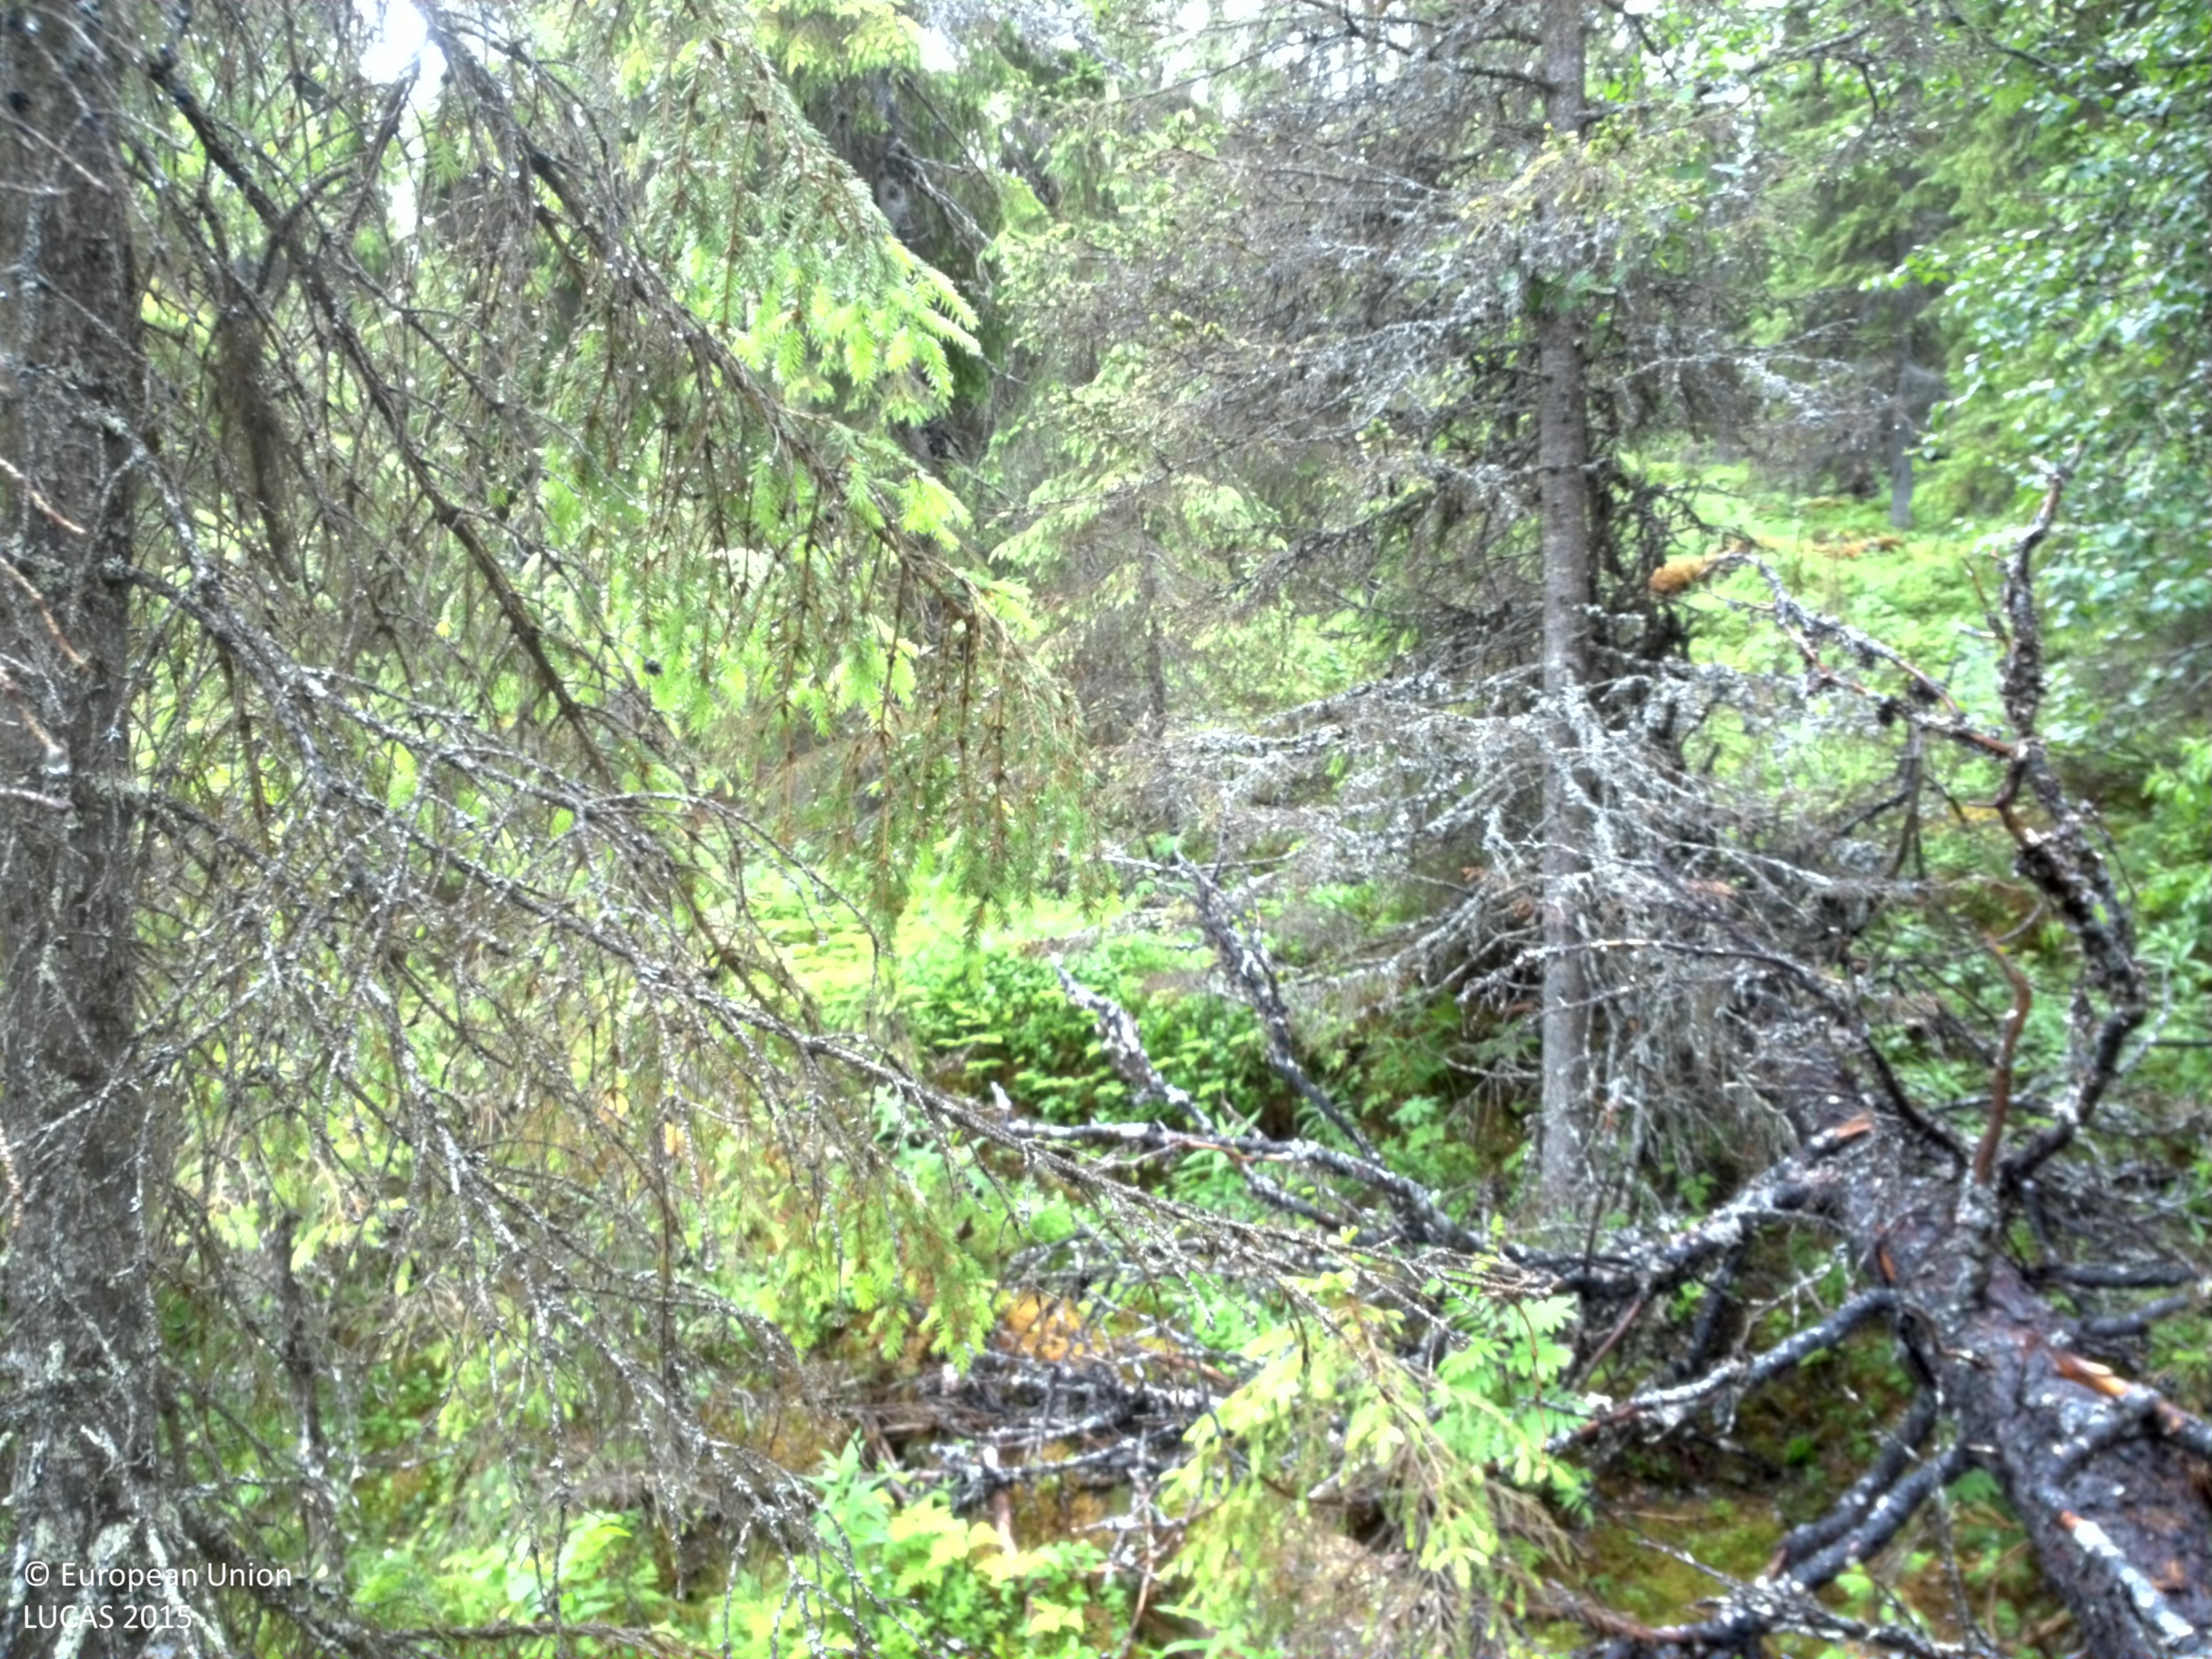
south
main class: Woodland
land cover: Spruce dominated coniferous woodland
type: boreal forest
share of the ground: 25 - 50 %
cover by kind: coniferous forest trees 30 %, shrubs 30 %, herbaceous plants 30 %, lichens and mosses 10 %
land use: Forestry
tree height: > 5 m
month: July
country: SE
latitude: 65.5125
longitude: 16.1245
